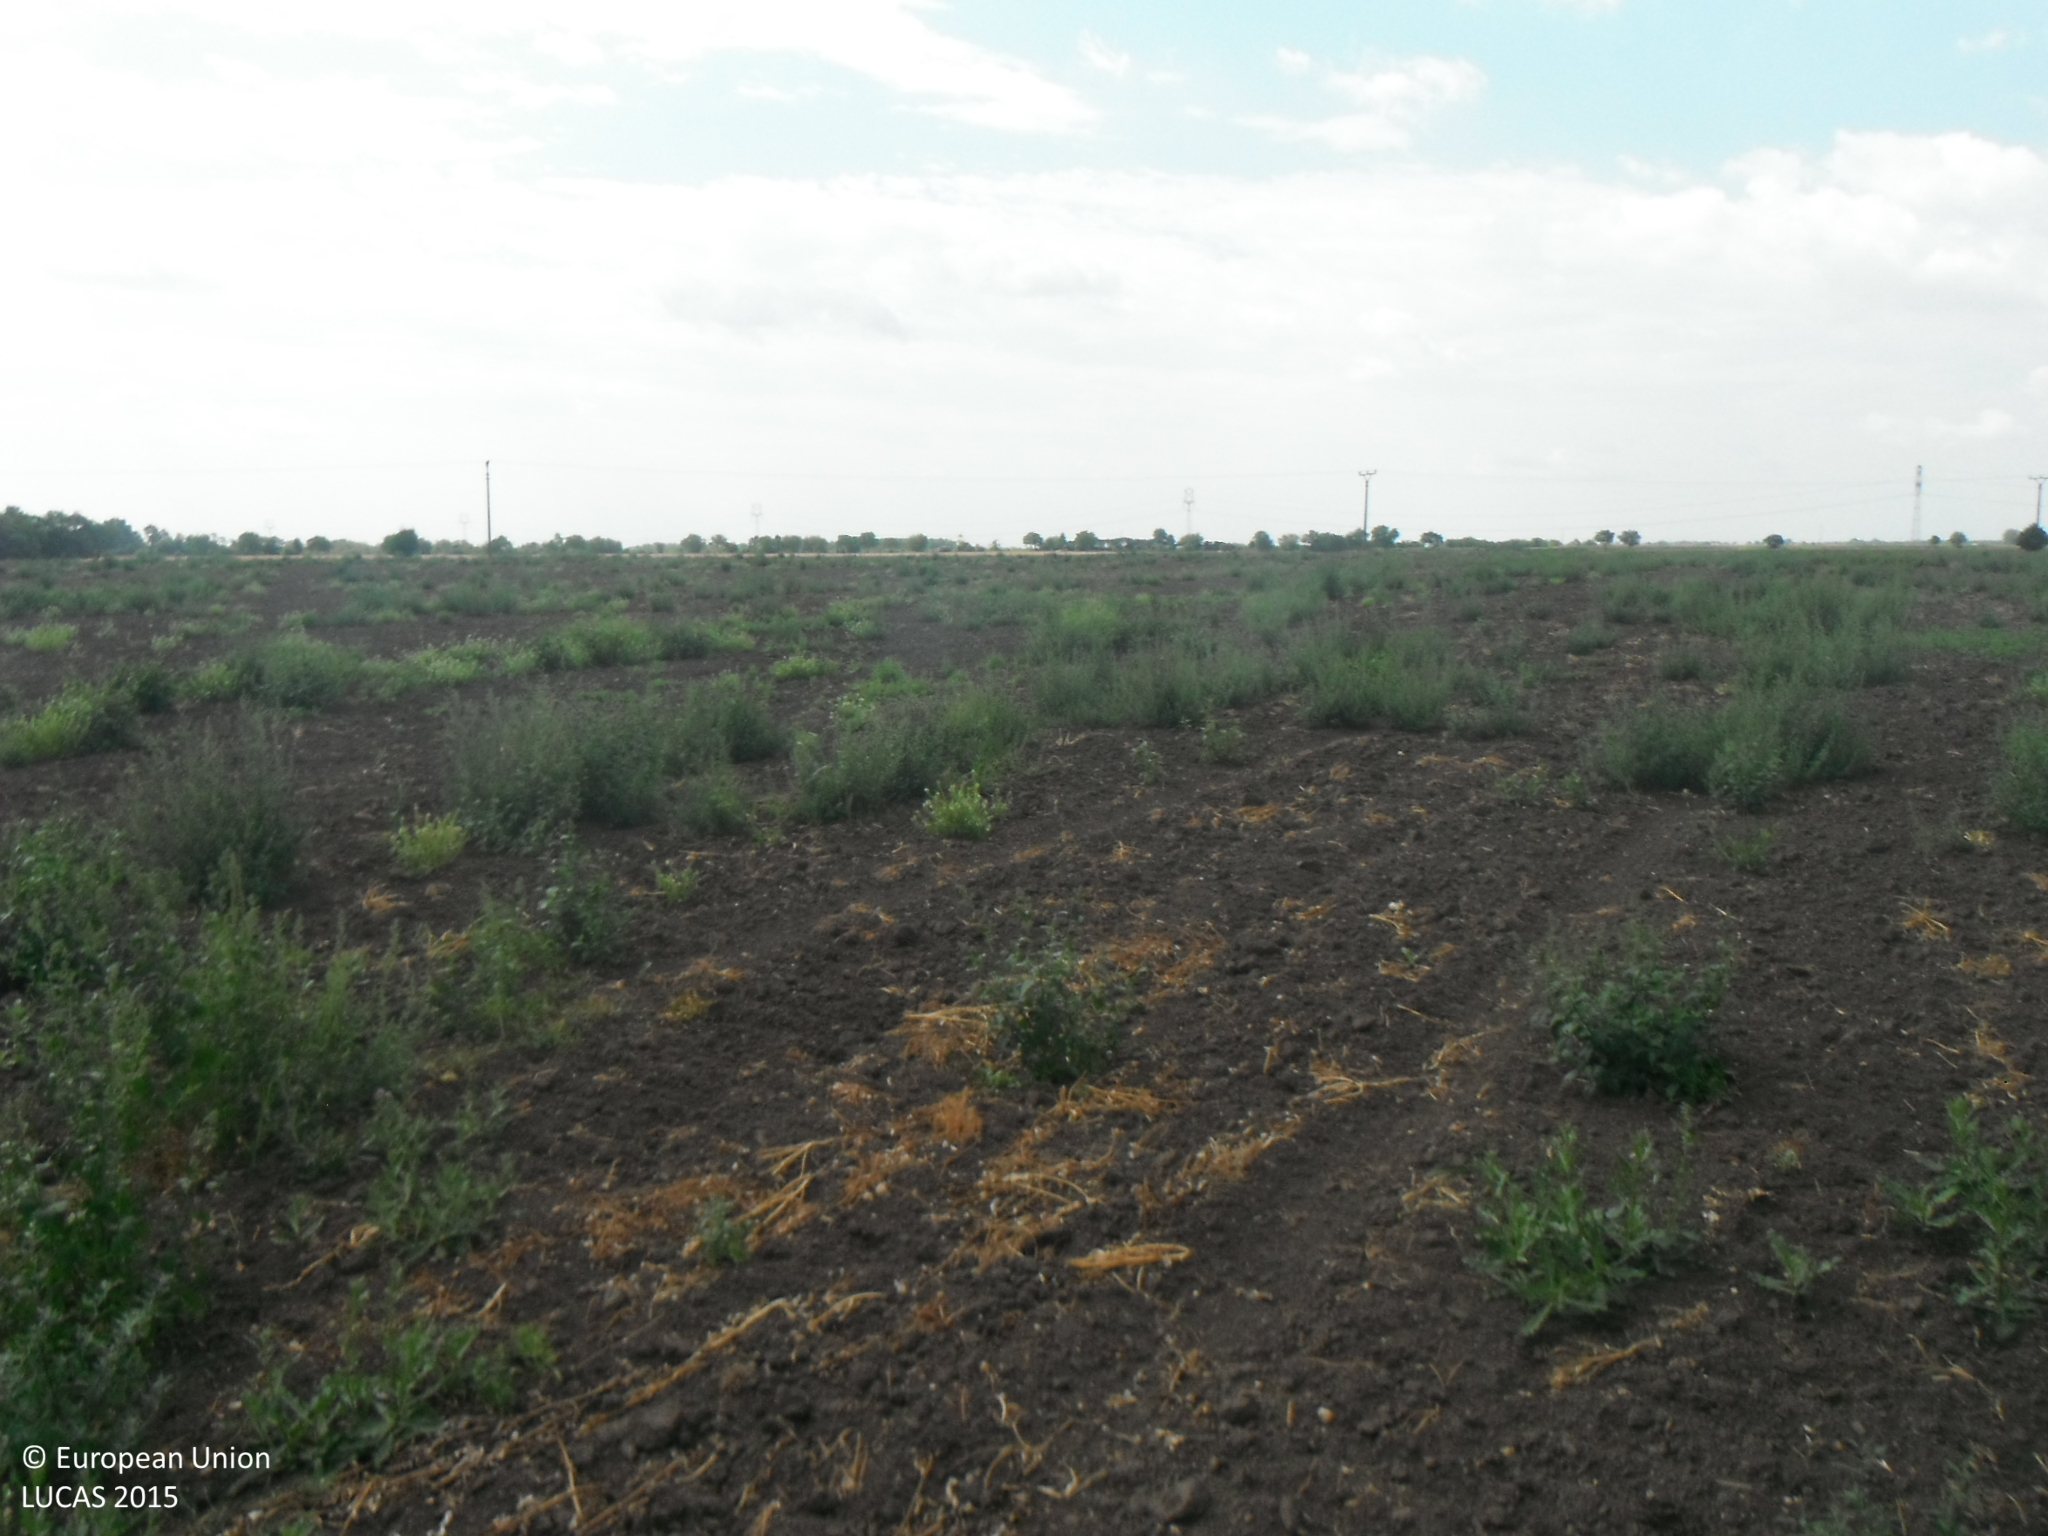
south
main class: Grassland
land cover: Spontaneously vegetated surfaces
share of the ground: 25 - 50 %
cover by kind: unconsolidated bare surface 65 %, herbaceous plants 35 %
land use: Fallow land
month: July
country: SK
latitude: 48.1024
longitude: 17.3817
